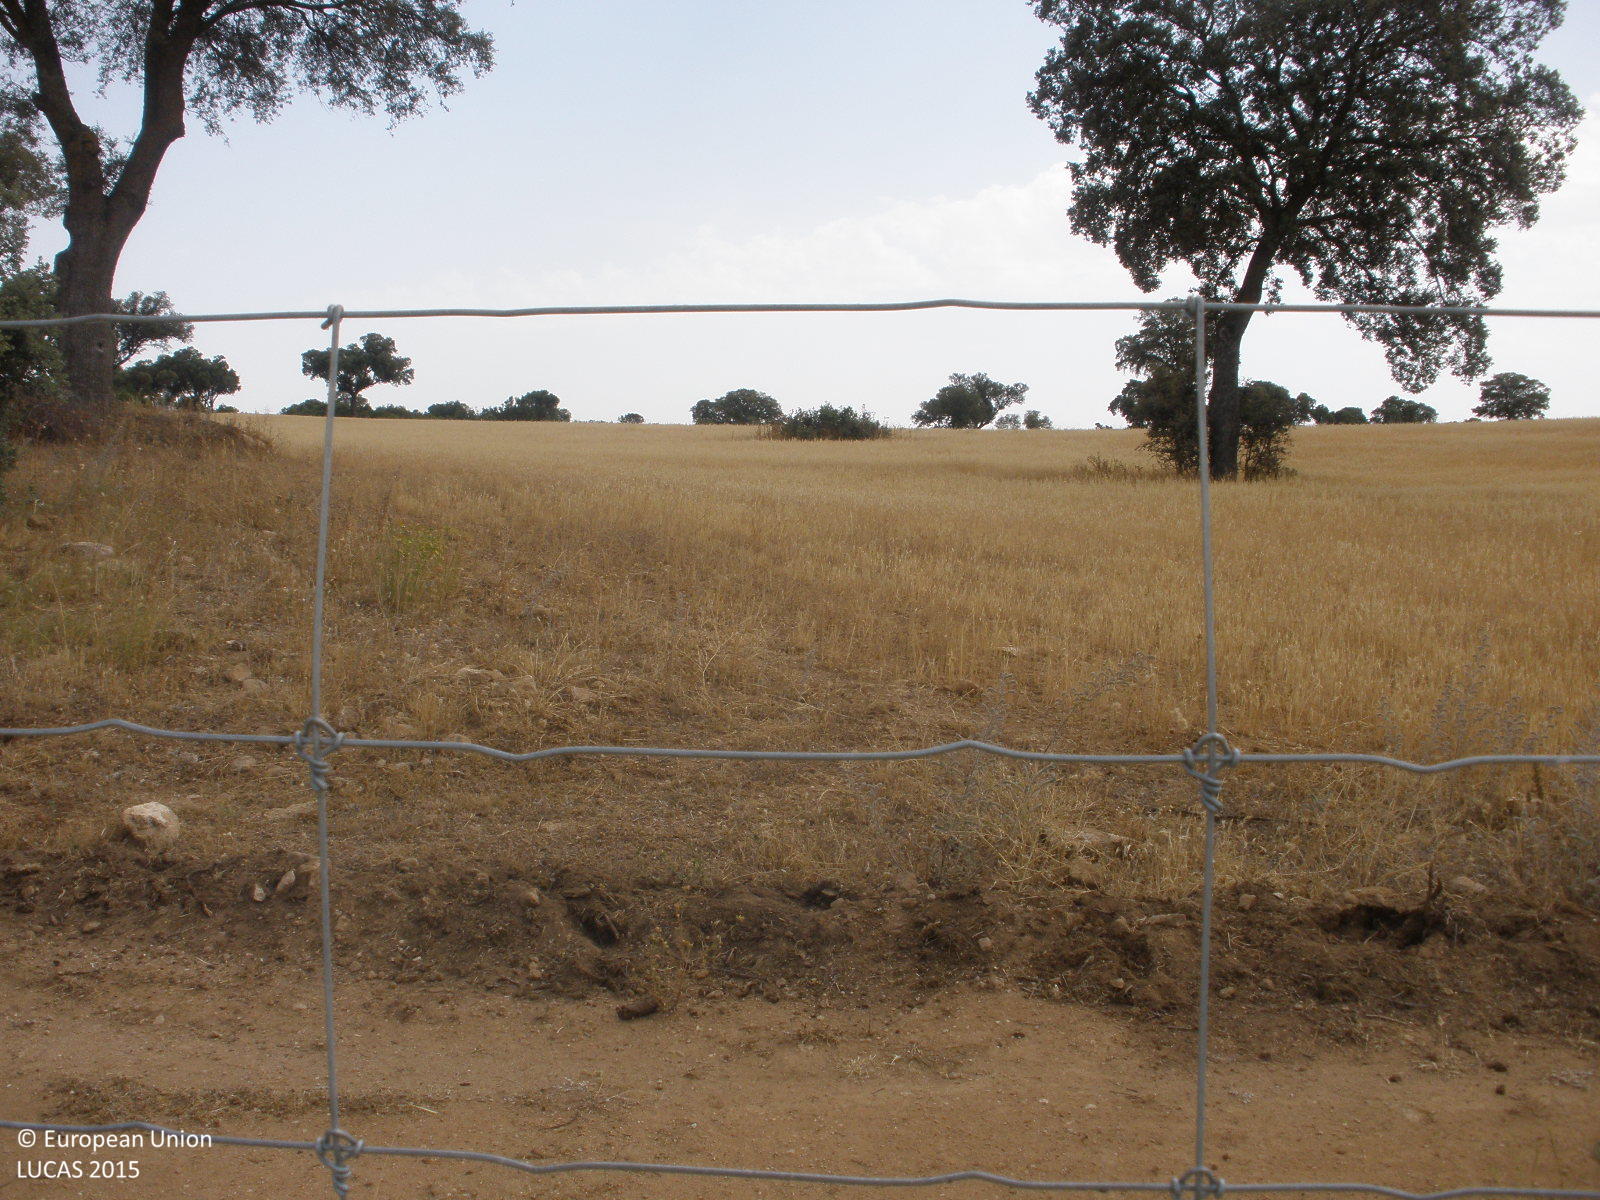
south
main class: Cropland
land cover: Oats
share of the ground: > 75 %
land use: Agriculture (excluding fallow land and kitchen gardens)
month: July
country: ES
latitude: 39.8079
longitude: -3.3527
